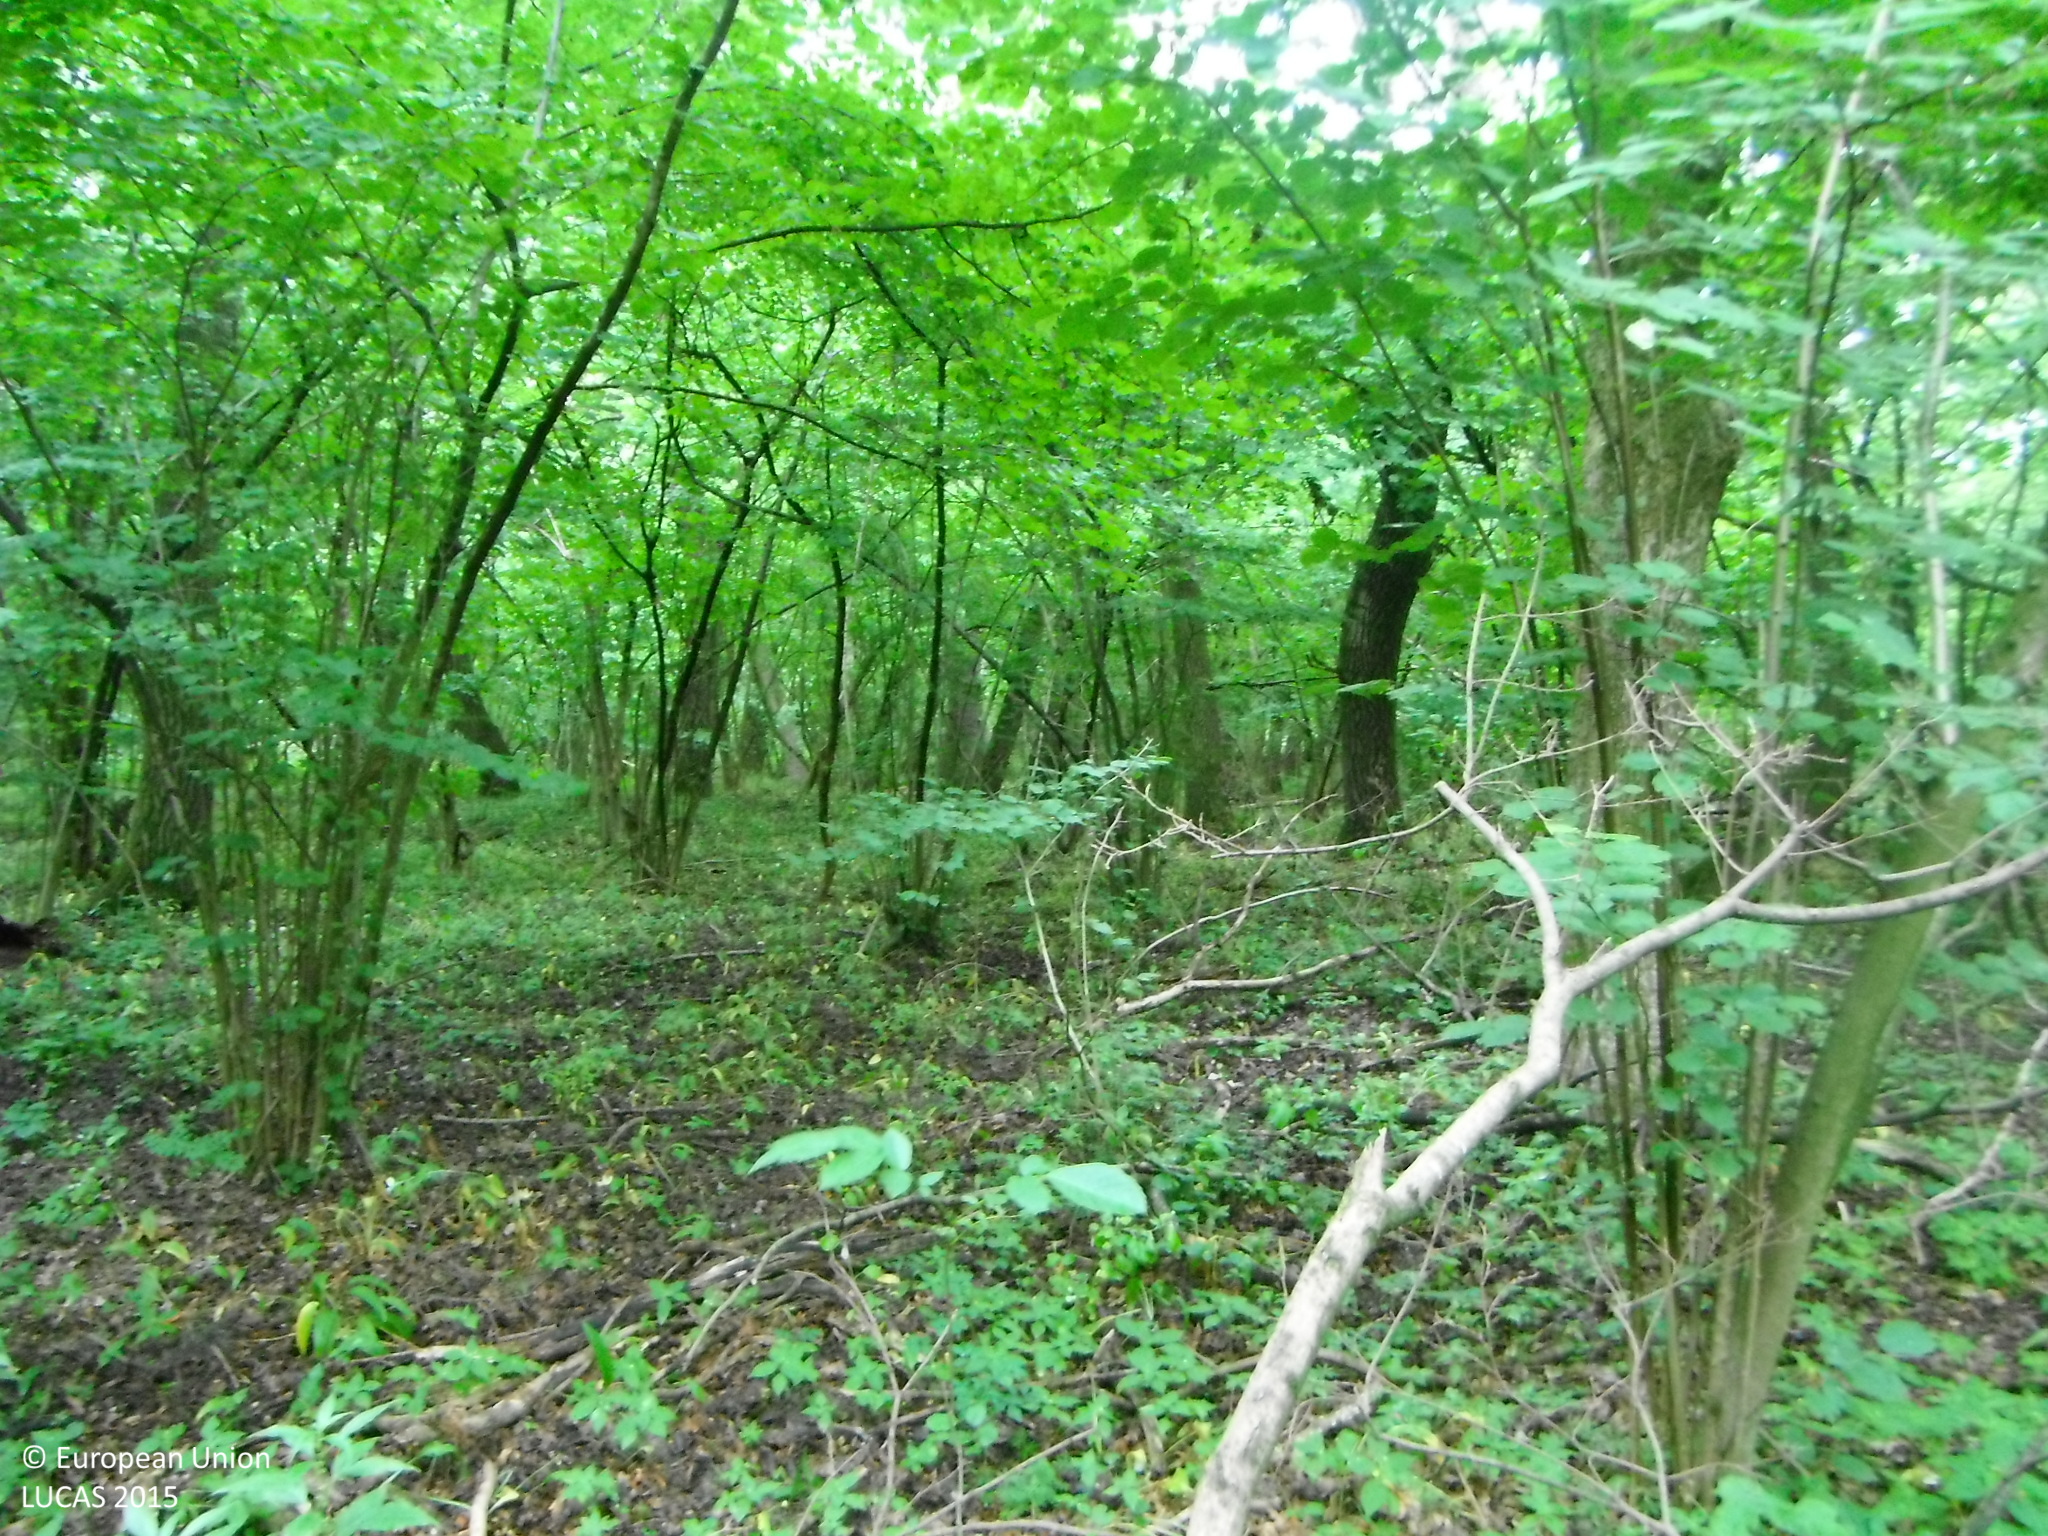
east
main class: Woodland
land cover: Broadleaved woodland
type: floodplain forest
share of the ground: > 75 %
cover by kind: broadleaved forest trees 90 %, herbaceous plants 10 %
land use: Forestry
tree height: > 5 m
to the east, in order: Broadleaved woodland; Tracks; Broadleaved woodland
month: June
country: SK
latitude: 48.0808
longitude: 17.1627
